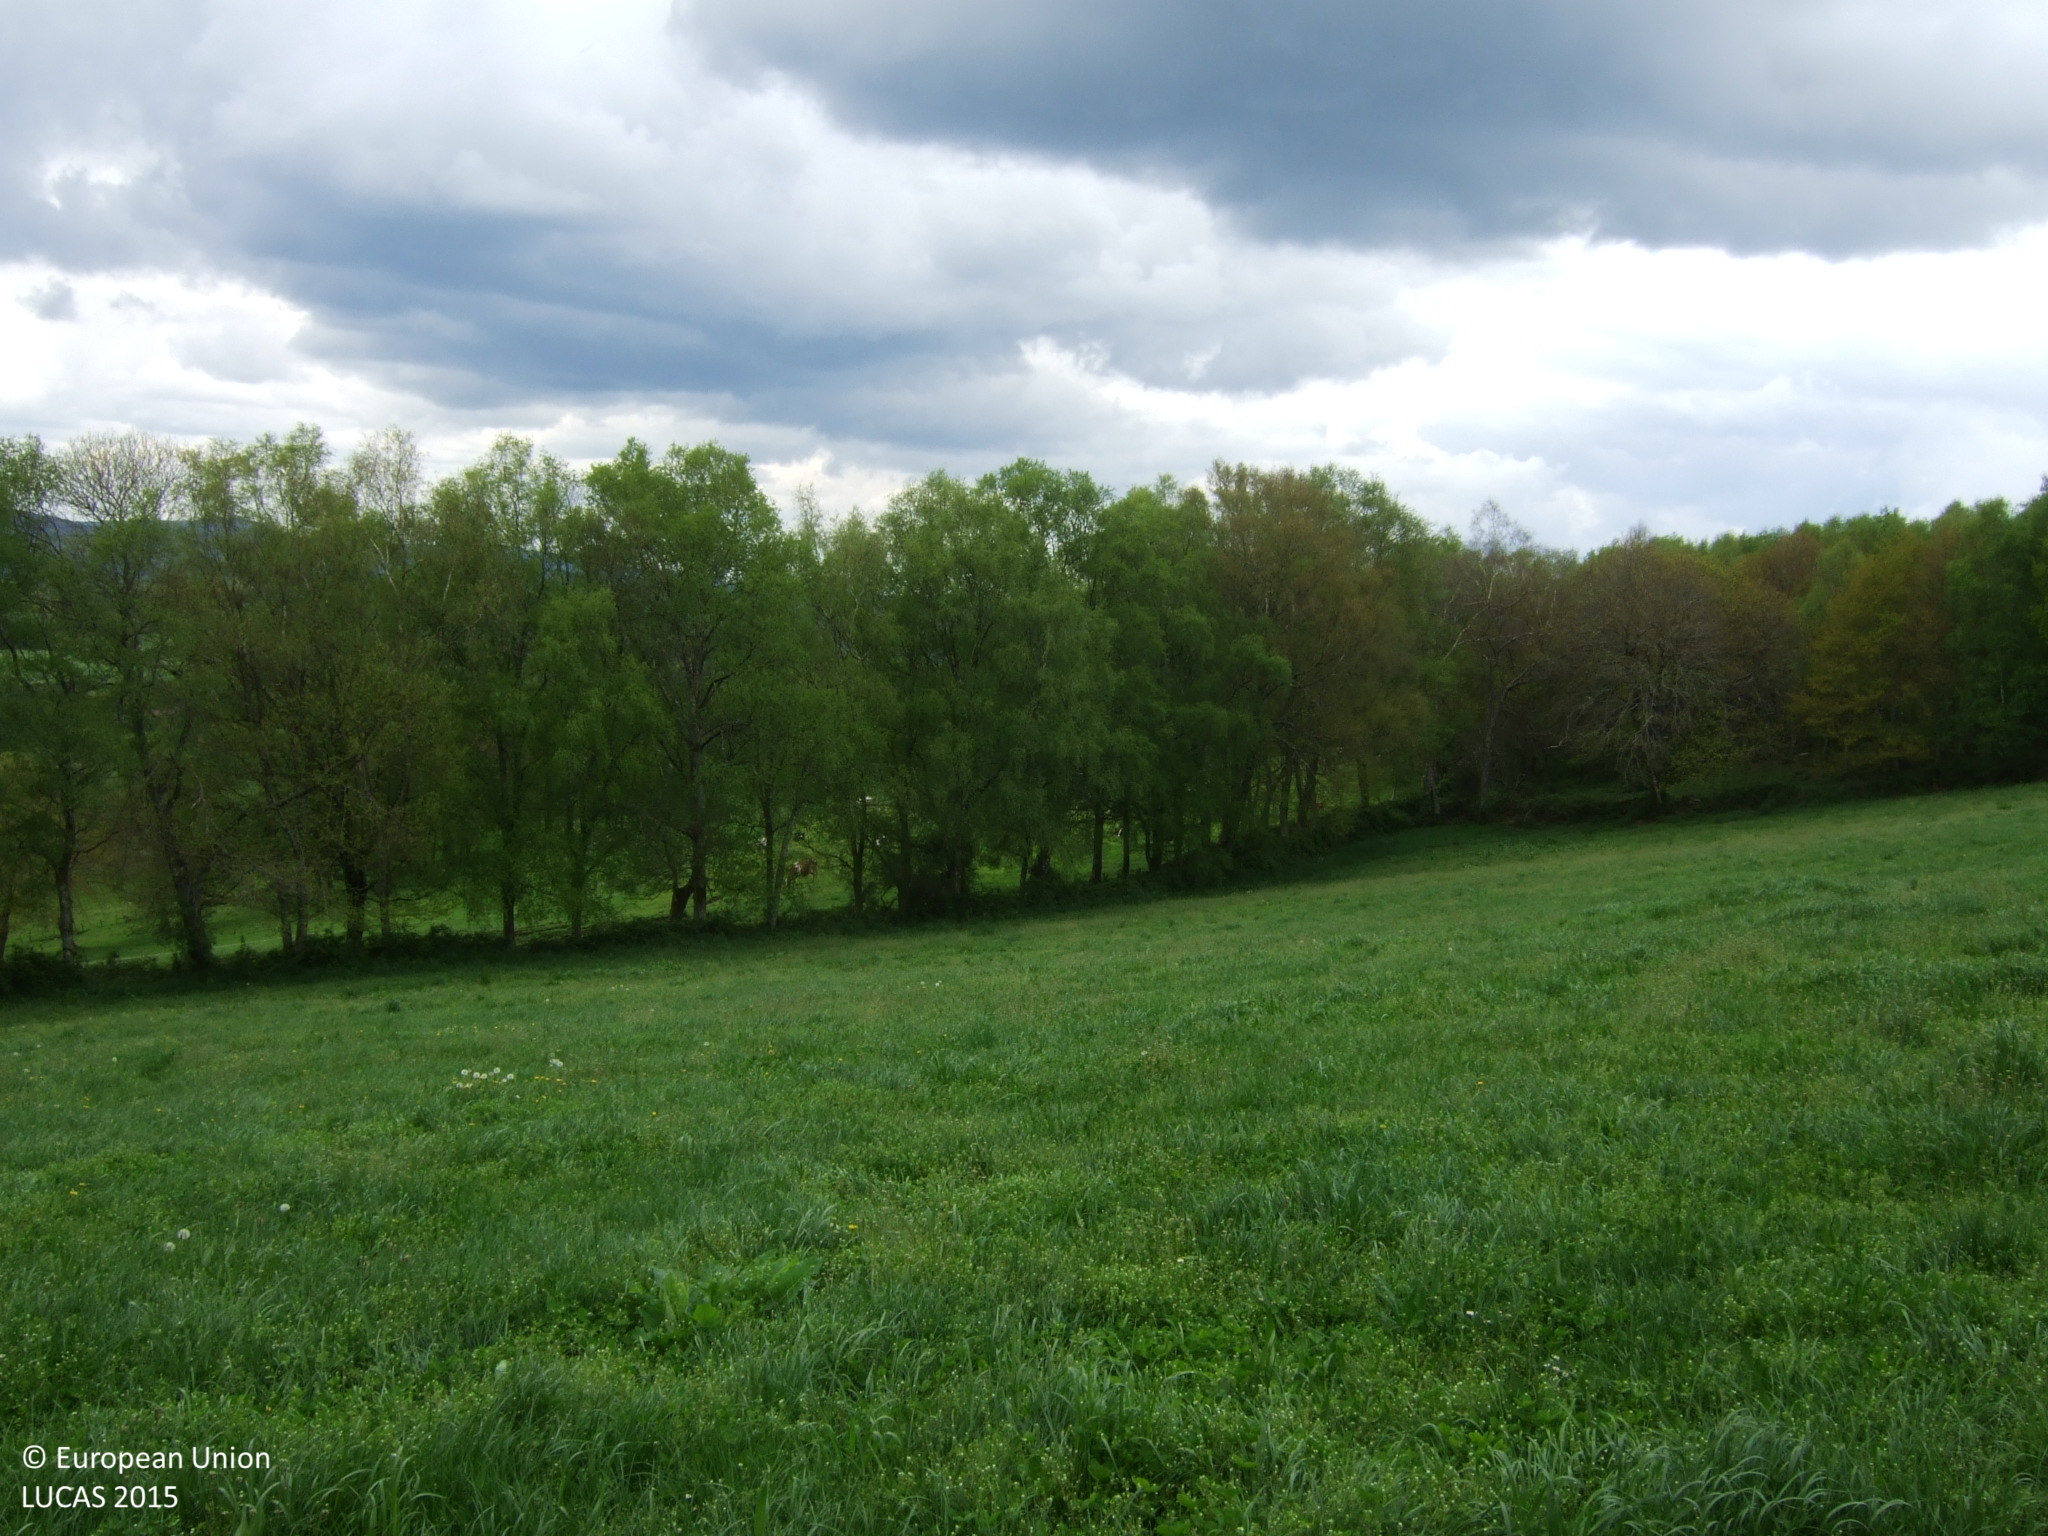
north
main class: Grassland
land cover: Grassland without tree/shrub cover
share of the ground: > 75 %
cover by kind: herbaceous plants 100 %
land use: Agriculture (excluding fallow land and kitchen gardens)
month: April
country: ES
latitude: 42.9890
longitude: -7.8568
